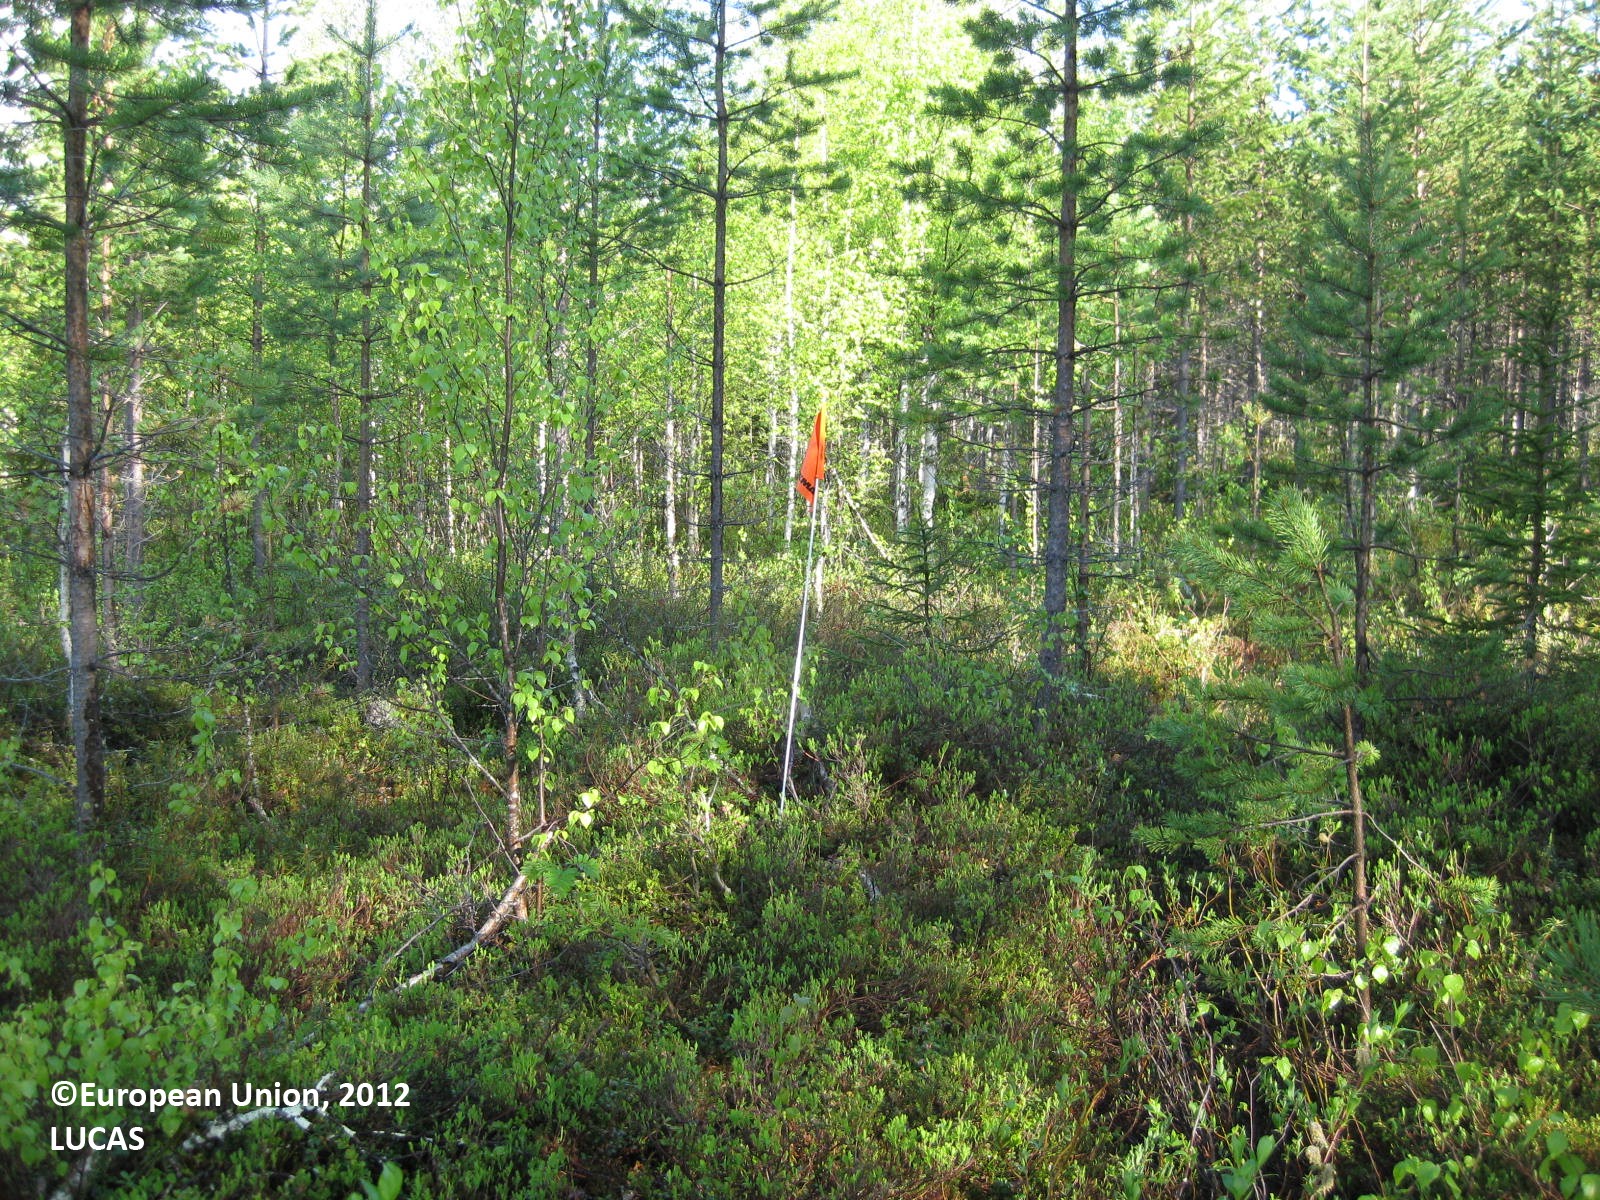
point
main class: Woodland
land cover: Pine dominated mixed woodland
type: boreal forest
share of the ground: 50 - 75 %
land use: Forestry
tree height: > 5 m
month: June
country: FI
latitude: 65.1278
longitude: 29.5766
